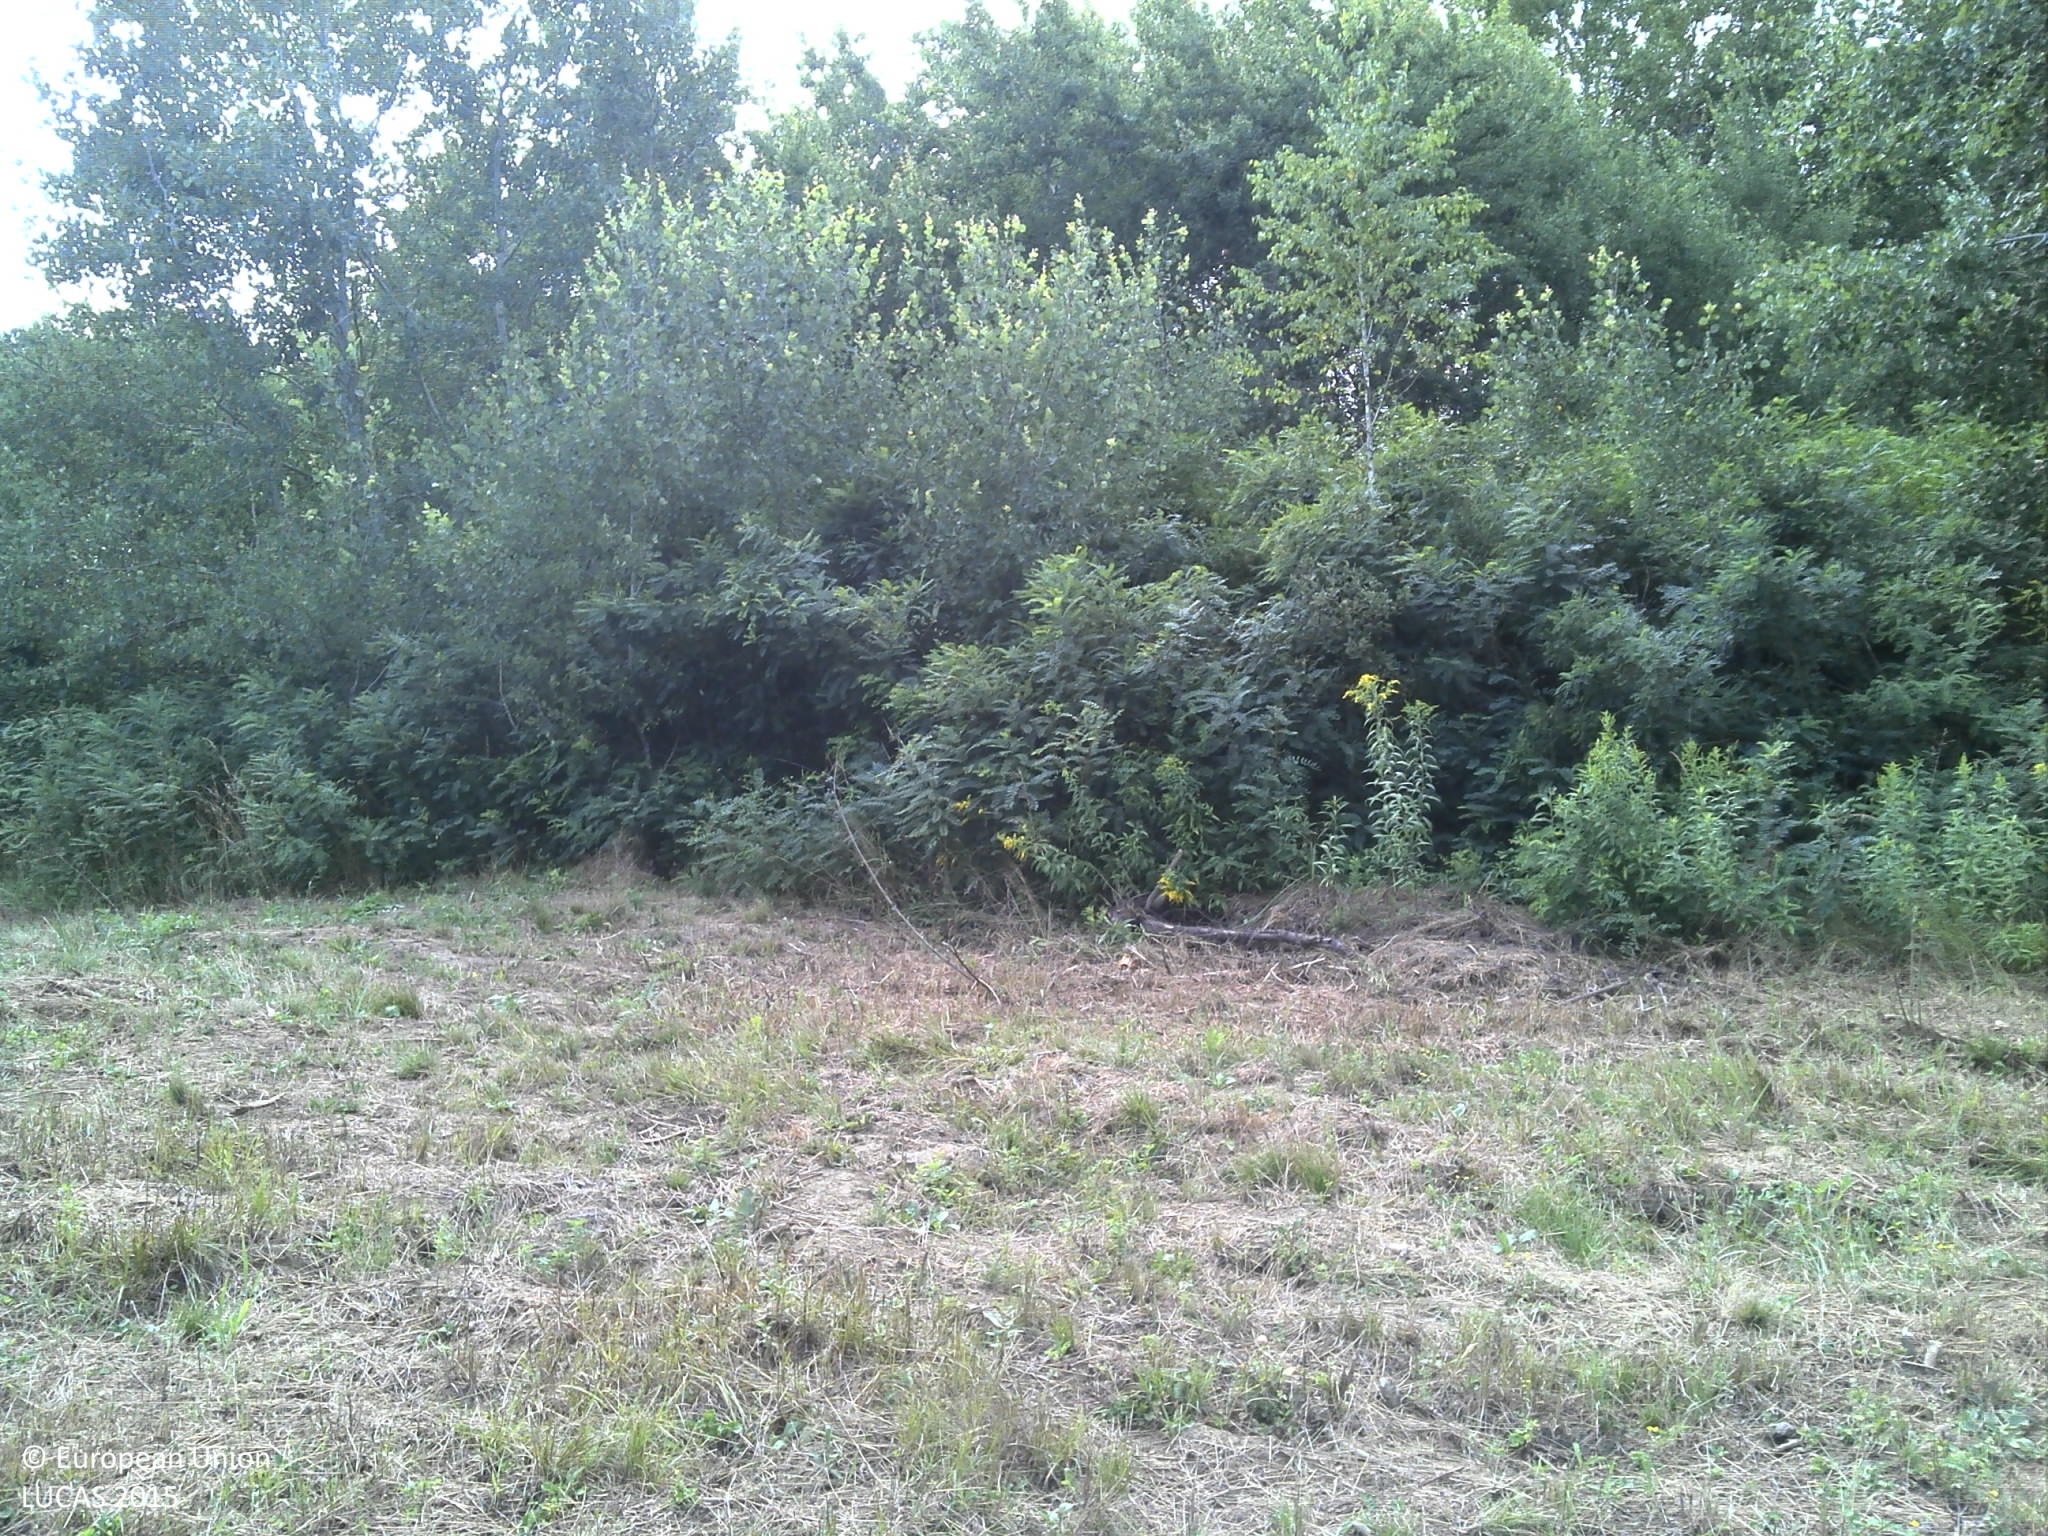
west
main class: Grassland
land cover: Grassland with sparse tree/shrub cover
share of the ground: > 75 %
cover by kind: herbaceous plants 90 %, broadleaved forest trees 5 %, shrubs 5 %
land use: Semi-natural and natural areas not in use
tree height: < 5 m
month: July
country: HR
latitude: 45.6082
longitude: 16.5508
